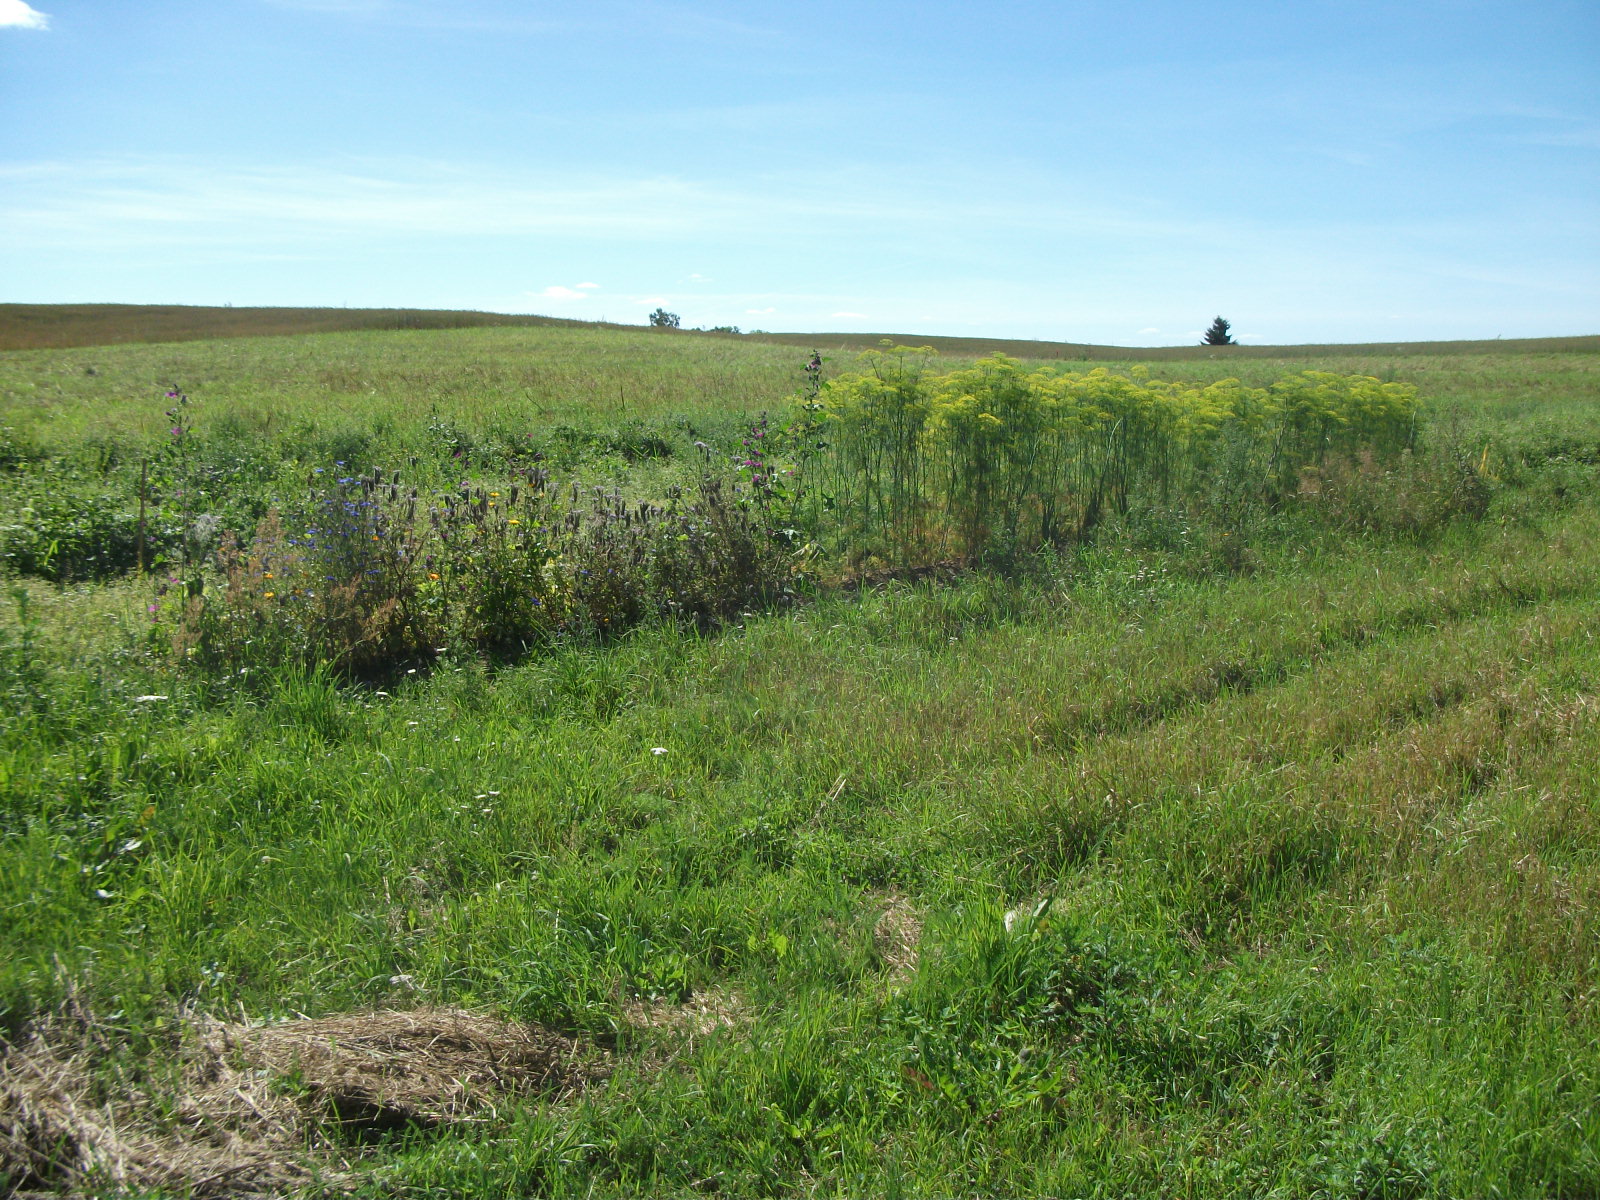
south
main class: Grassland
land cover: Grassland without tree/shrub cover
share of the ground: > 75 %
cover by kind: herbaceous plants 100 %
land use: Agriculture (excluding fallow land and kitchen gardens)
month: August
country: LV
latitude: 56.6981
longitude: 26.1574
